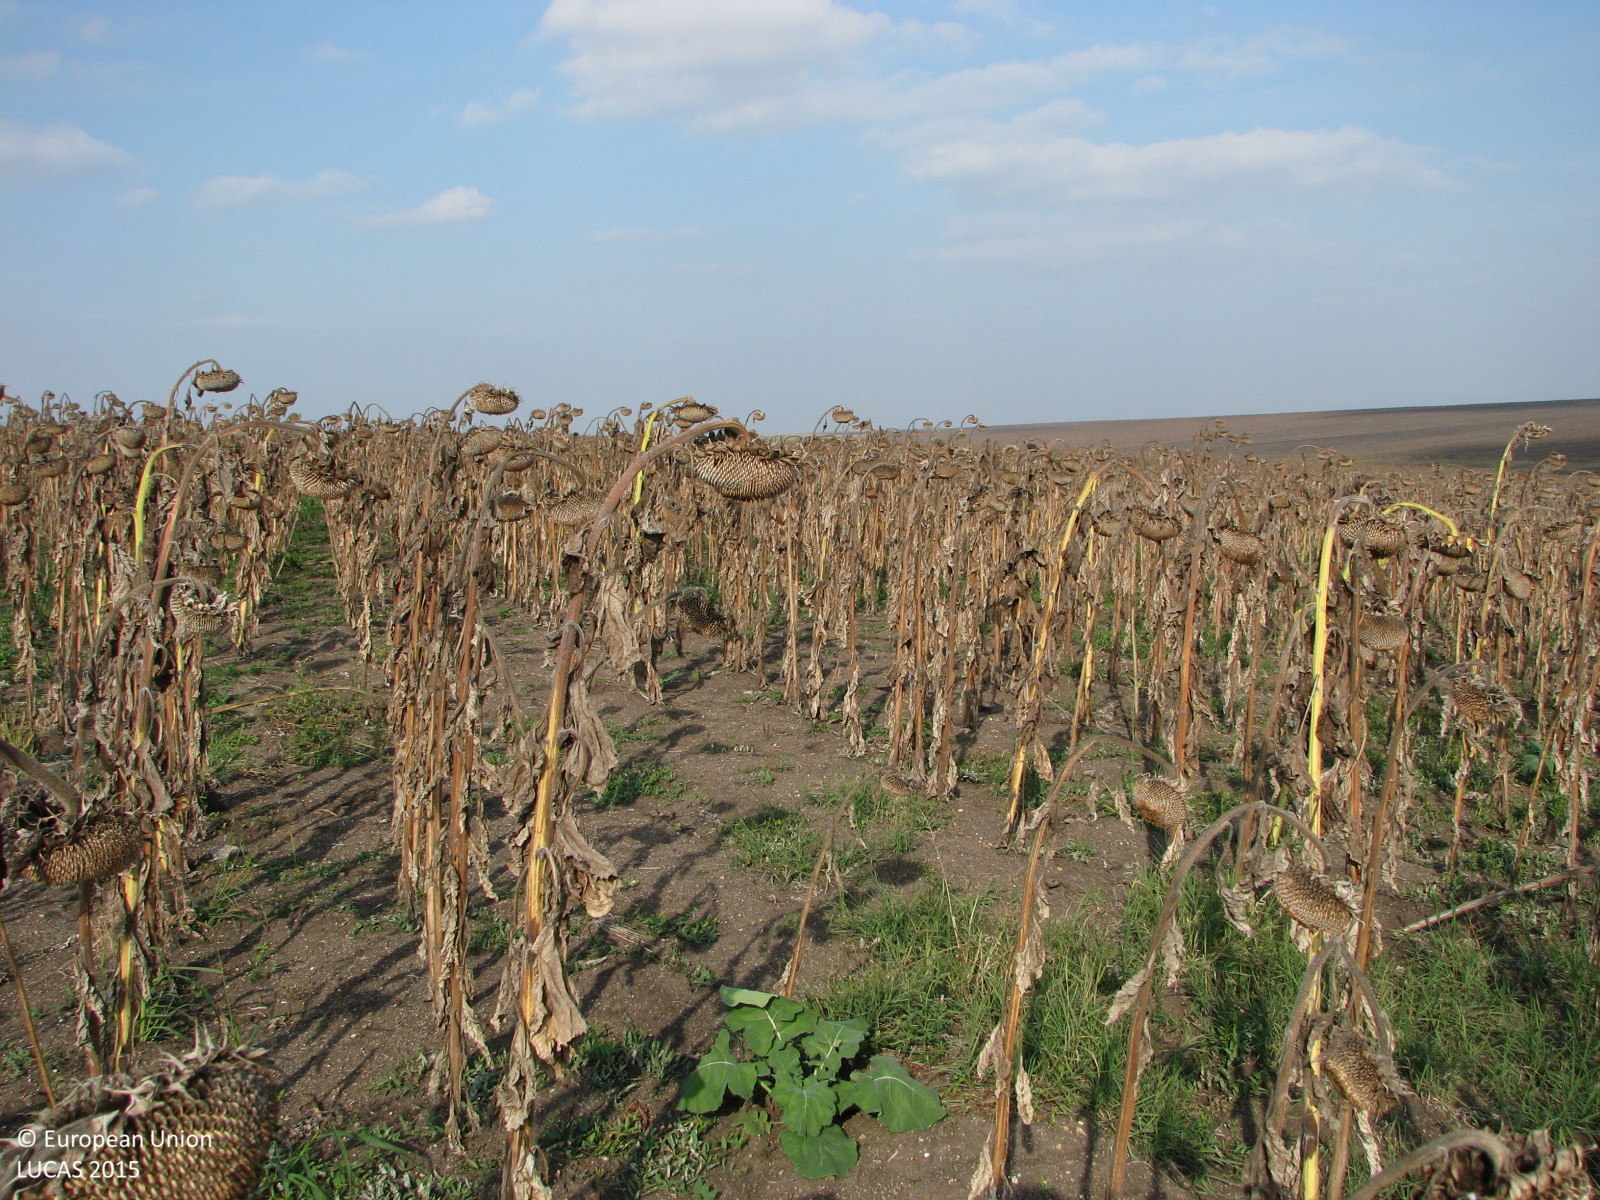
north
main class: Cropland
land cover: Sunflower
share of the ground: > 75 %
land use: Agriculture (excluding fallow land and kitchen gardens)
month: October
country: BG
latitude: 42.3481
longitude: 26.4404
